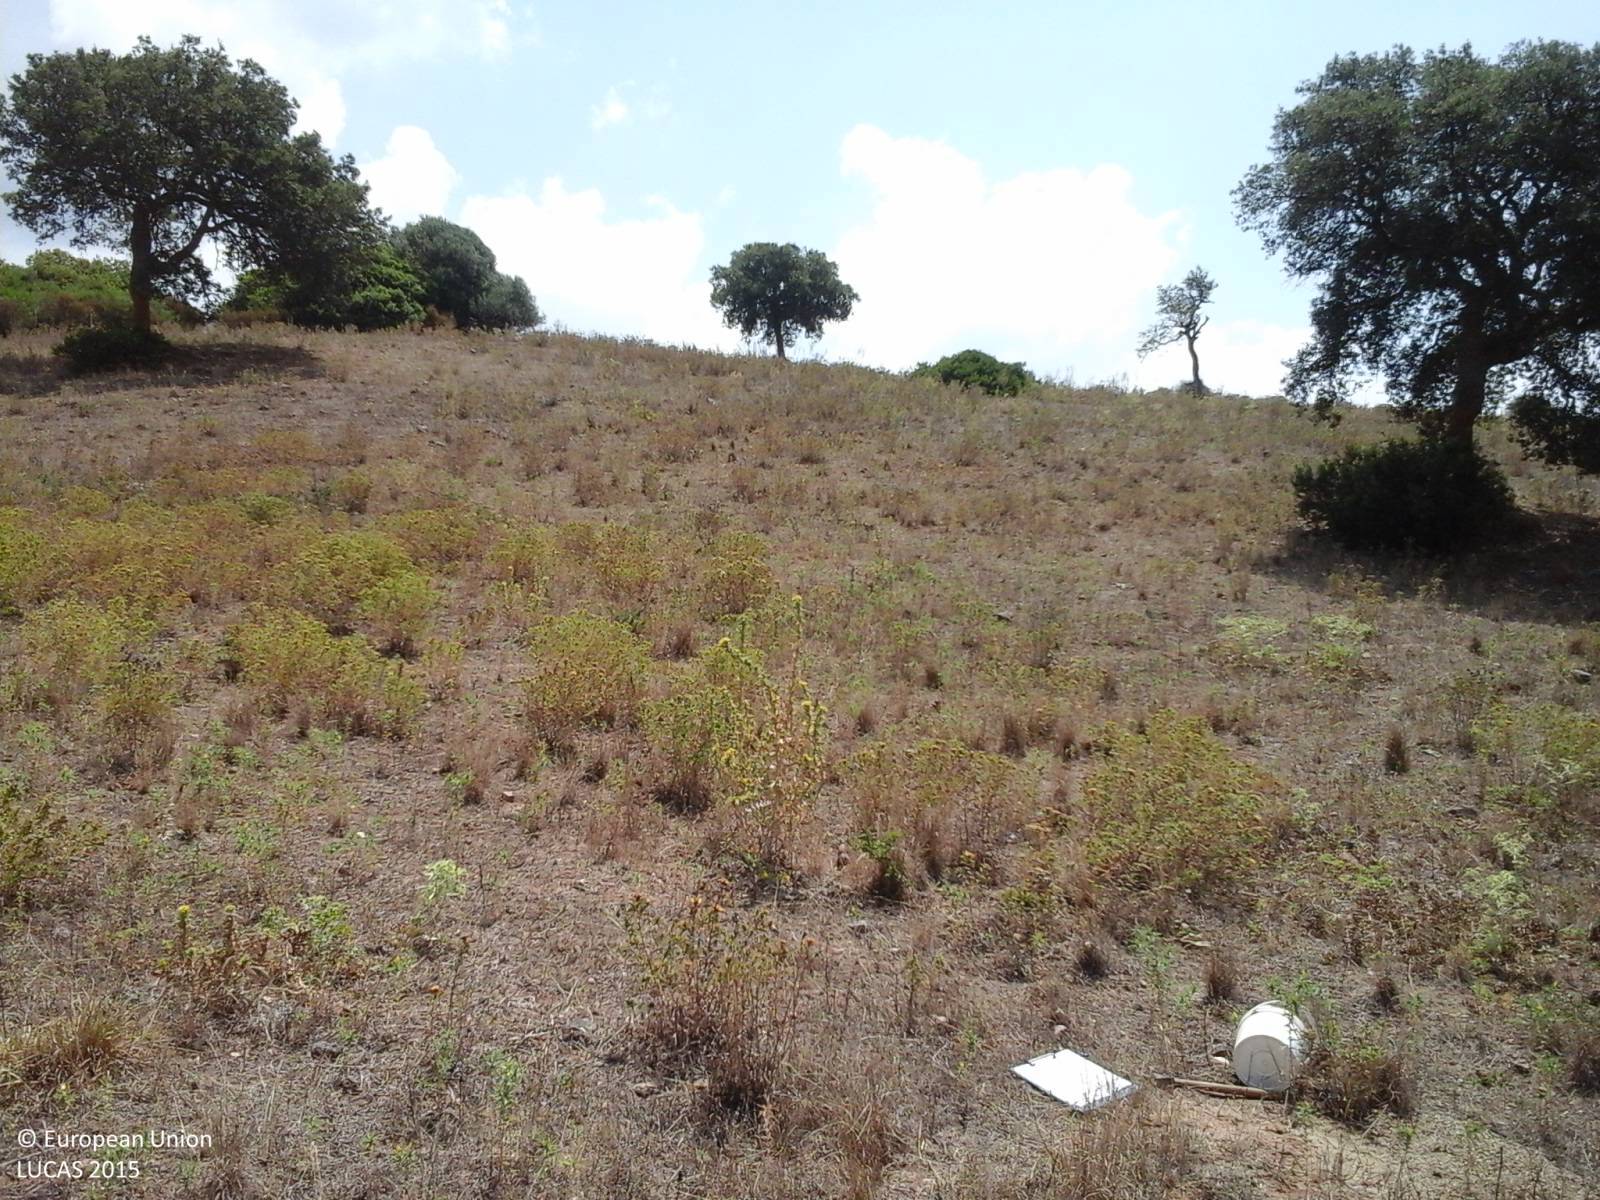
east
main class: Woodland
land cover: Broadleaved woodland
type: thermophilous deciduous forest
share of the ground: 25 - 50 %
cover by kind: broadleaved forest trees 65 %, shrubs 35 %
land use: Forestry
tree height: < 5 m
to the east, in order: Broadleaved woodland; Grassland without tree/shrub cover; Single bushes/trees; Grassland without tree/shrub cover; Abandoned hedges; Grass margins; Paved roads, cycling and walking lanes; Grass margins; Dry stone walls; Grassland without tree/shrub cover; Single bushes/trees; Grassland without tree/shrub cover
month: July
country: IT
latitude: 39.9895
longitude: 8.8935
